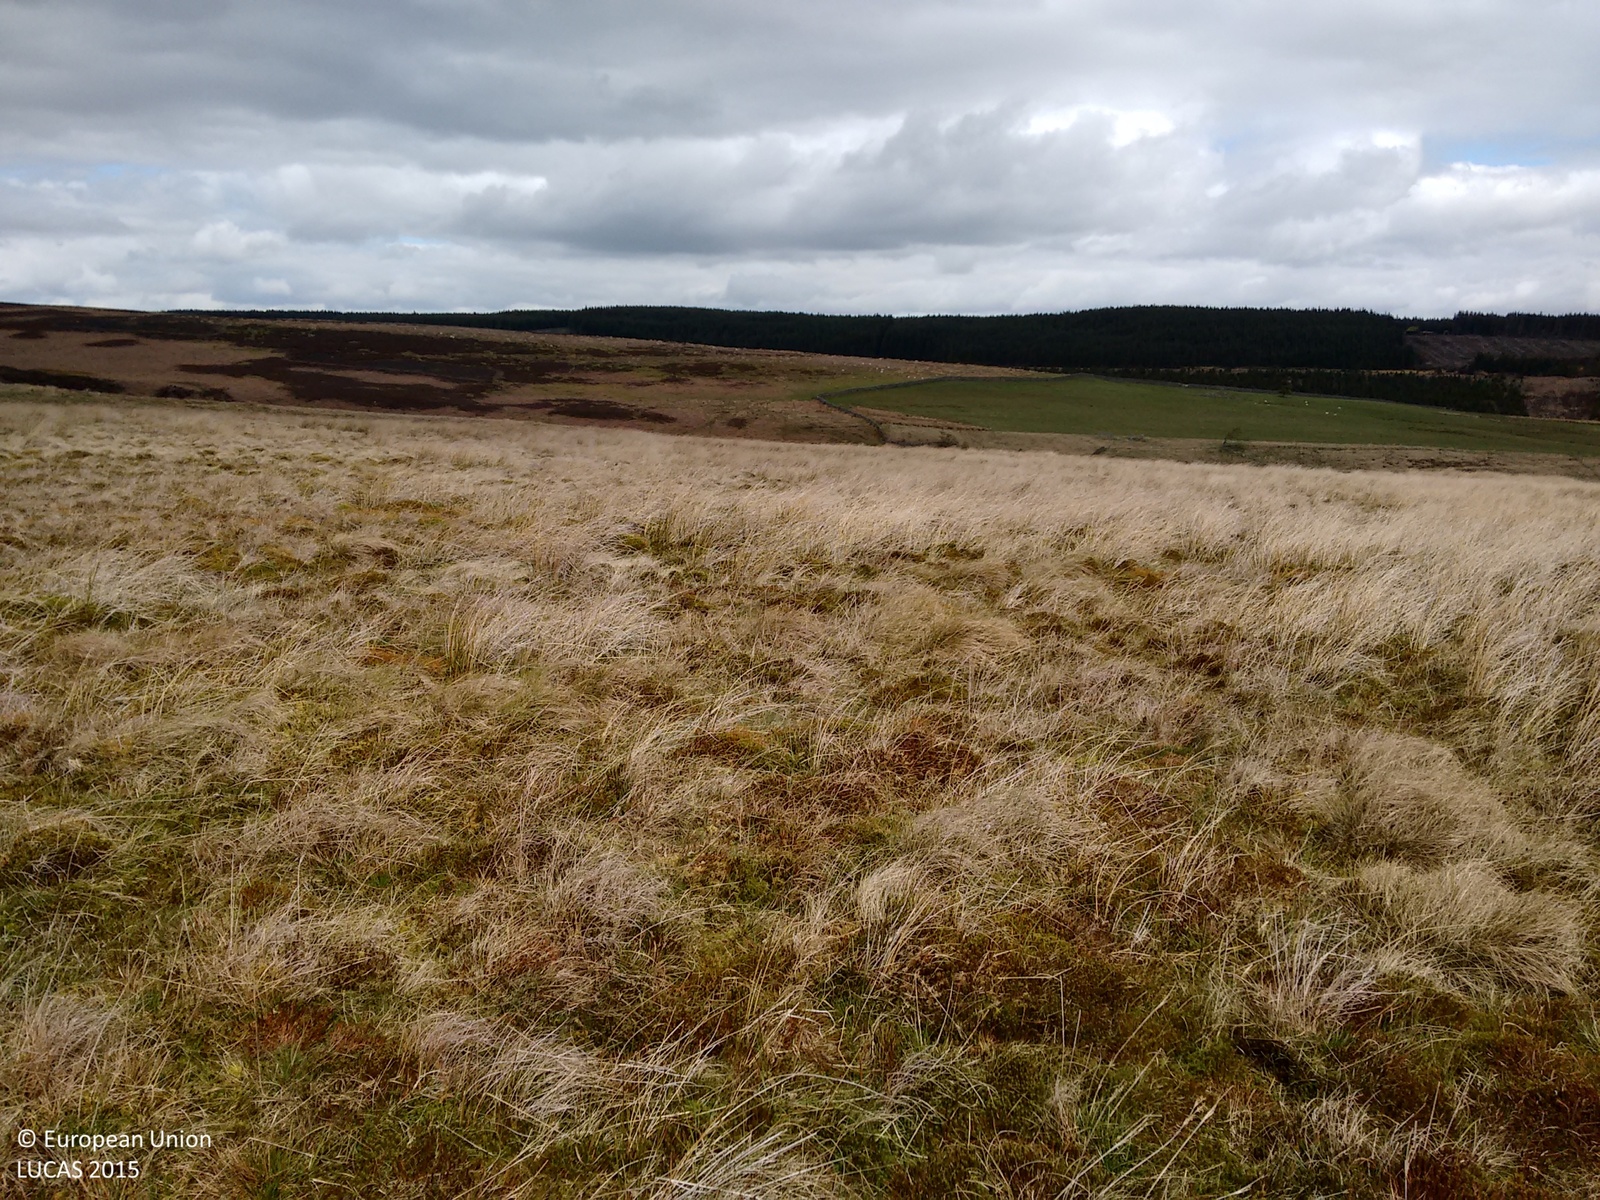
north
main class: Grassland
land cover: Grassland without tree/shrub cover
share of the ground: > 75 %
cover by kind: herbaceous plants 100 %
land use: Agriculture (excluding fallow land and kitchen gardens)
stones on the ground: < 10 %
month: May
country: GB
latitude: 54.8723
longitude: -2.0392
